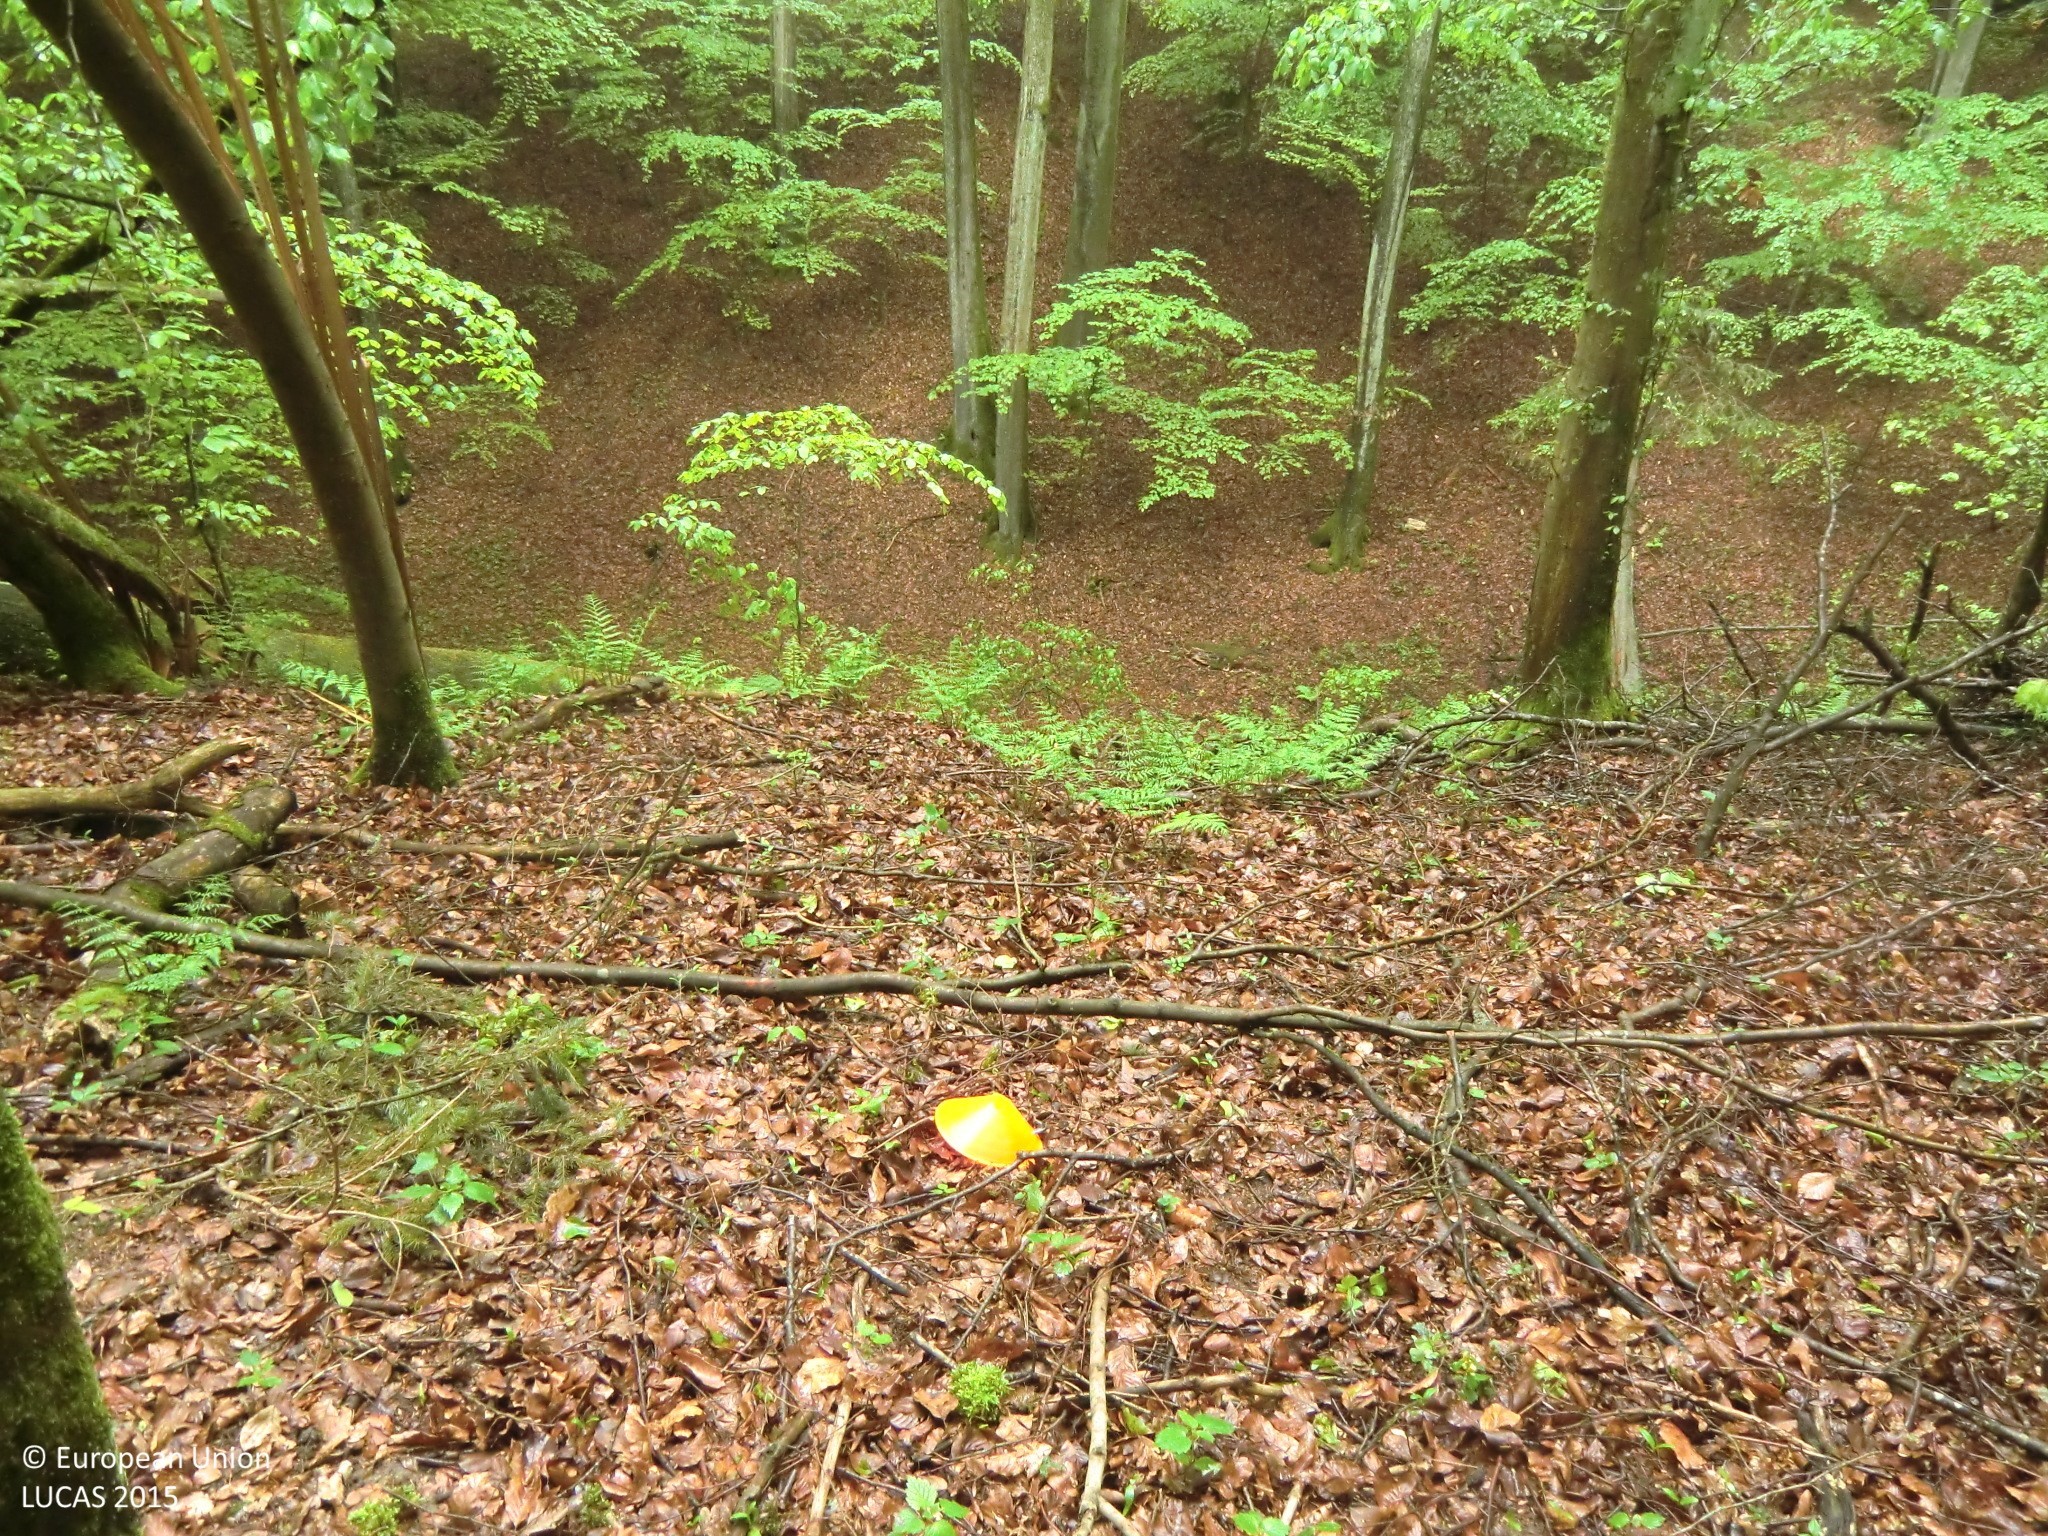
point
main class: Woodland
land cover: Broadleaved woodland
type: beech forest
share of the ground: > 75 %
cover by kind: broadleaved forest trees 80 %, unconsolidated bare surface 15 %, herbaceous plants 5 %
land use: Forestry
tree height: > 5 m
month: May
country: AT
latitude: 48.2292
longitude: 14.7529
